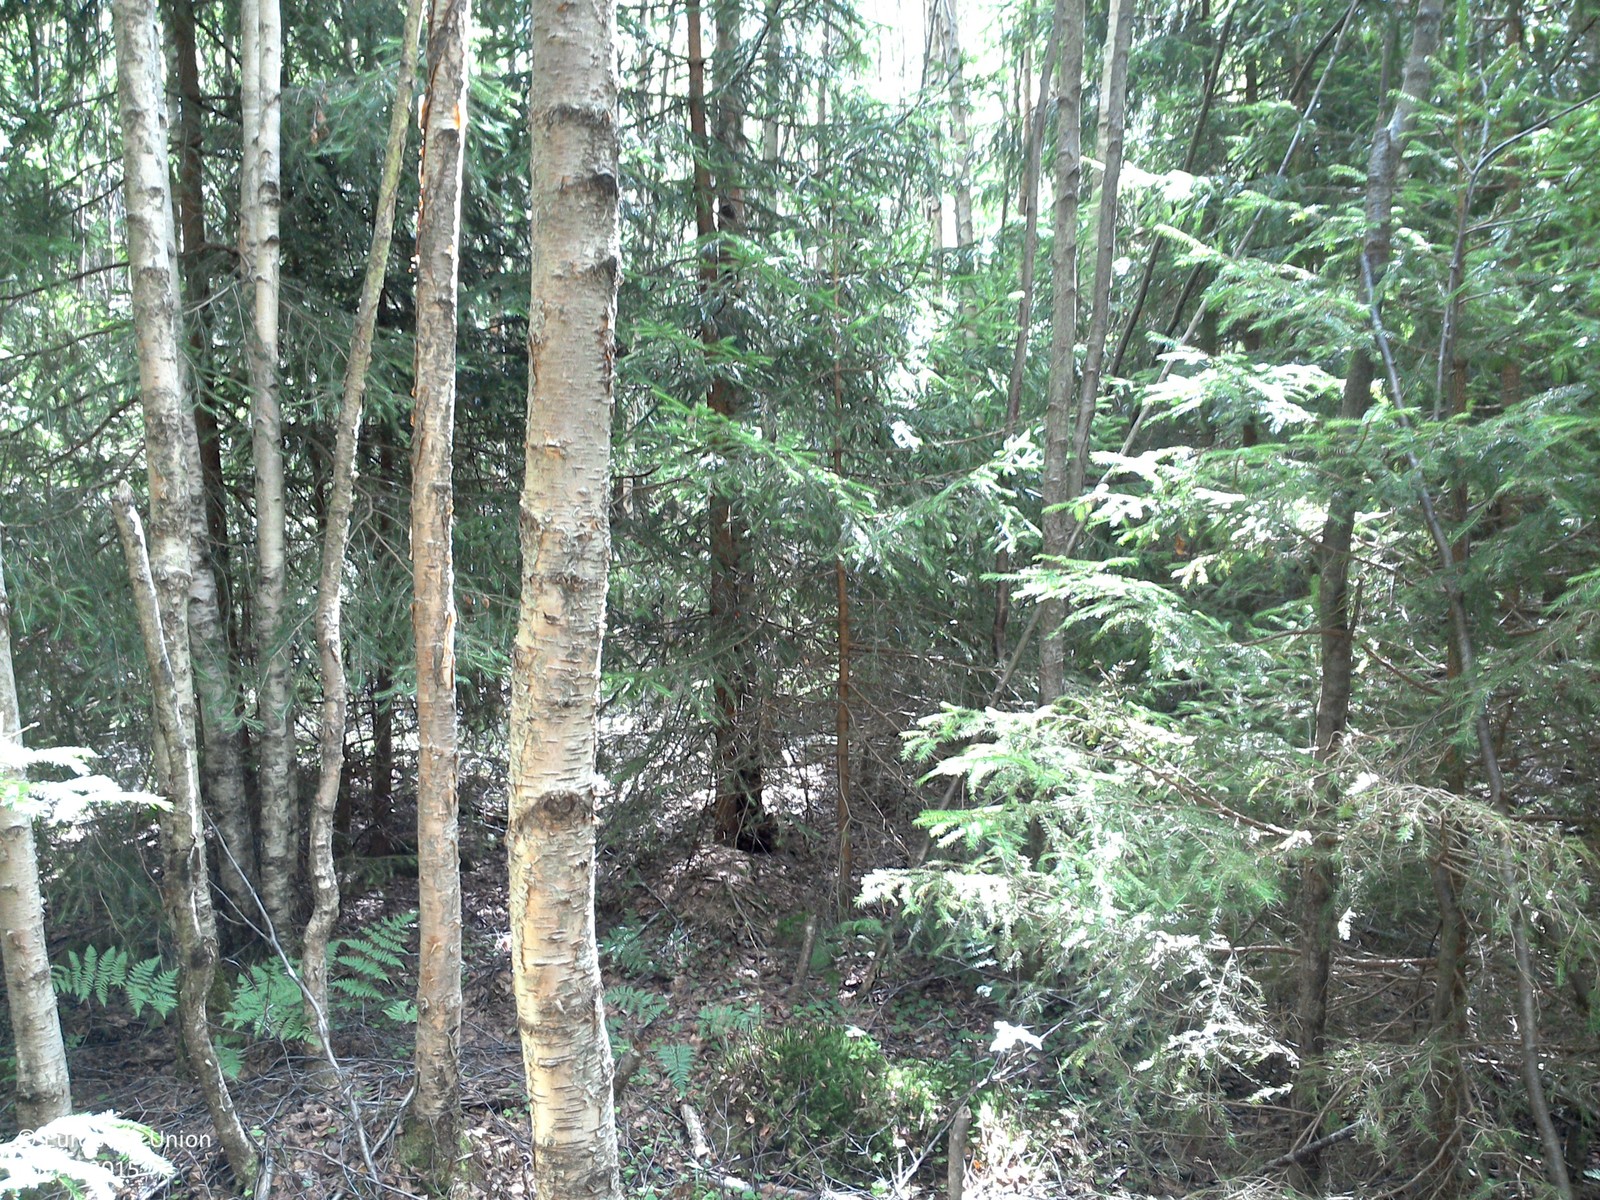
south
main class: Woodland
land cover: Broadleaved woodland
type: boreal forest
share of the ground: > 75 %
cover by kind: broadleaved forest trees 70 %, herbaceous plants 20 %, coniferous forest trees 10 %
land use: Forestry
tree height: > 5 m
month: July
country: SE
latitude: 58.0071
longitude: 14.8177
